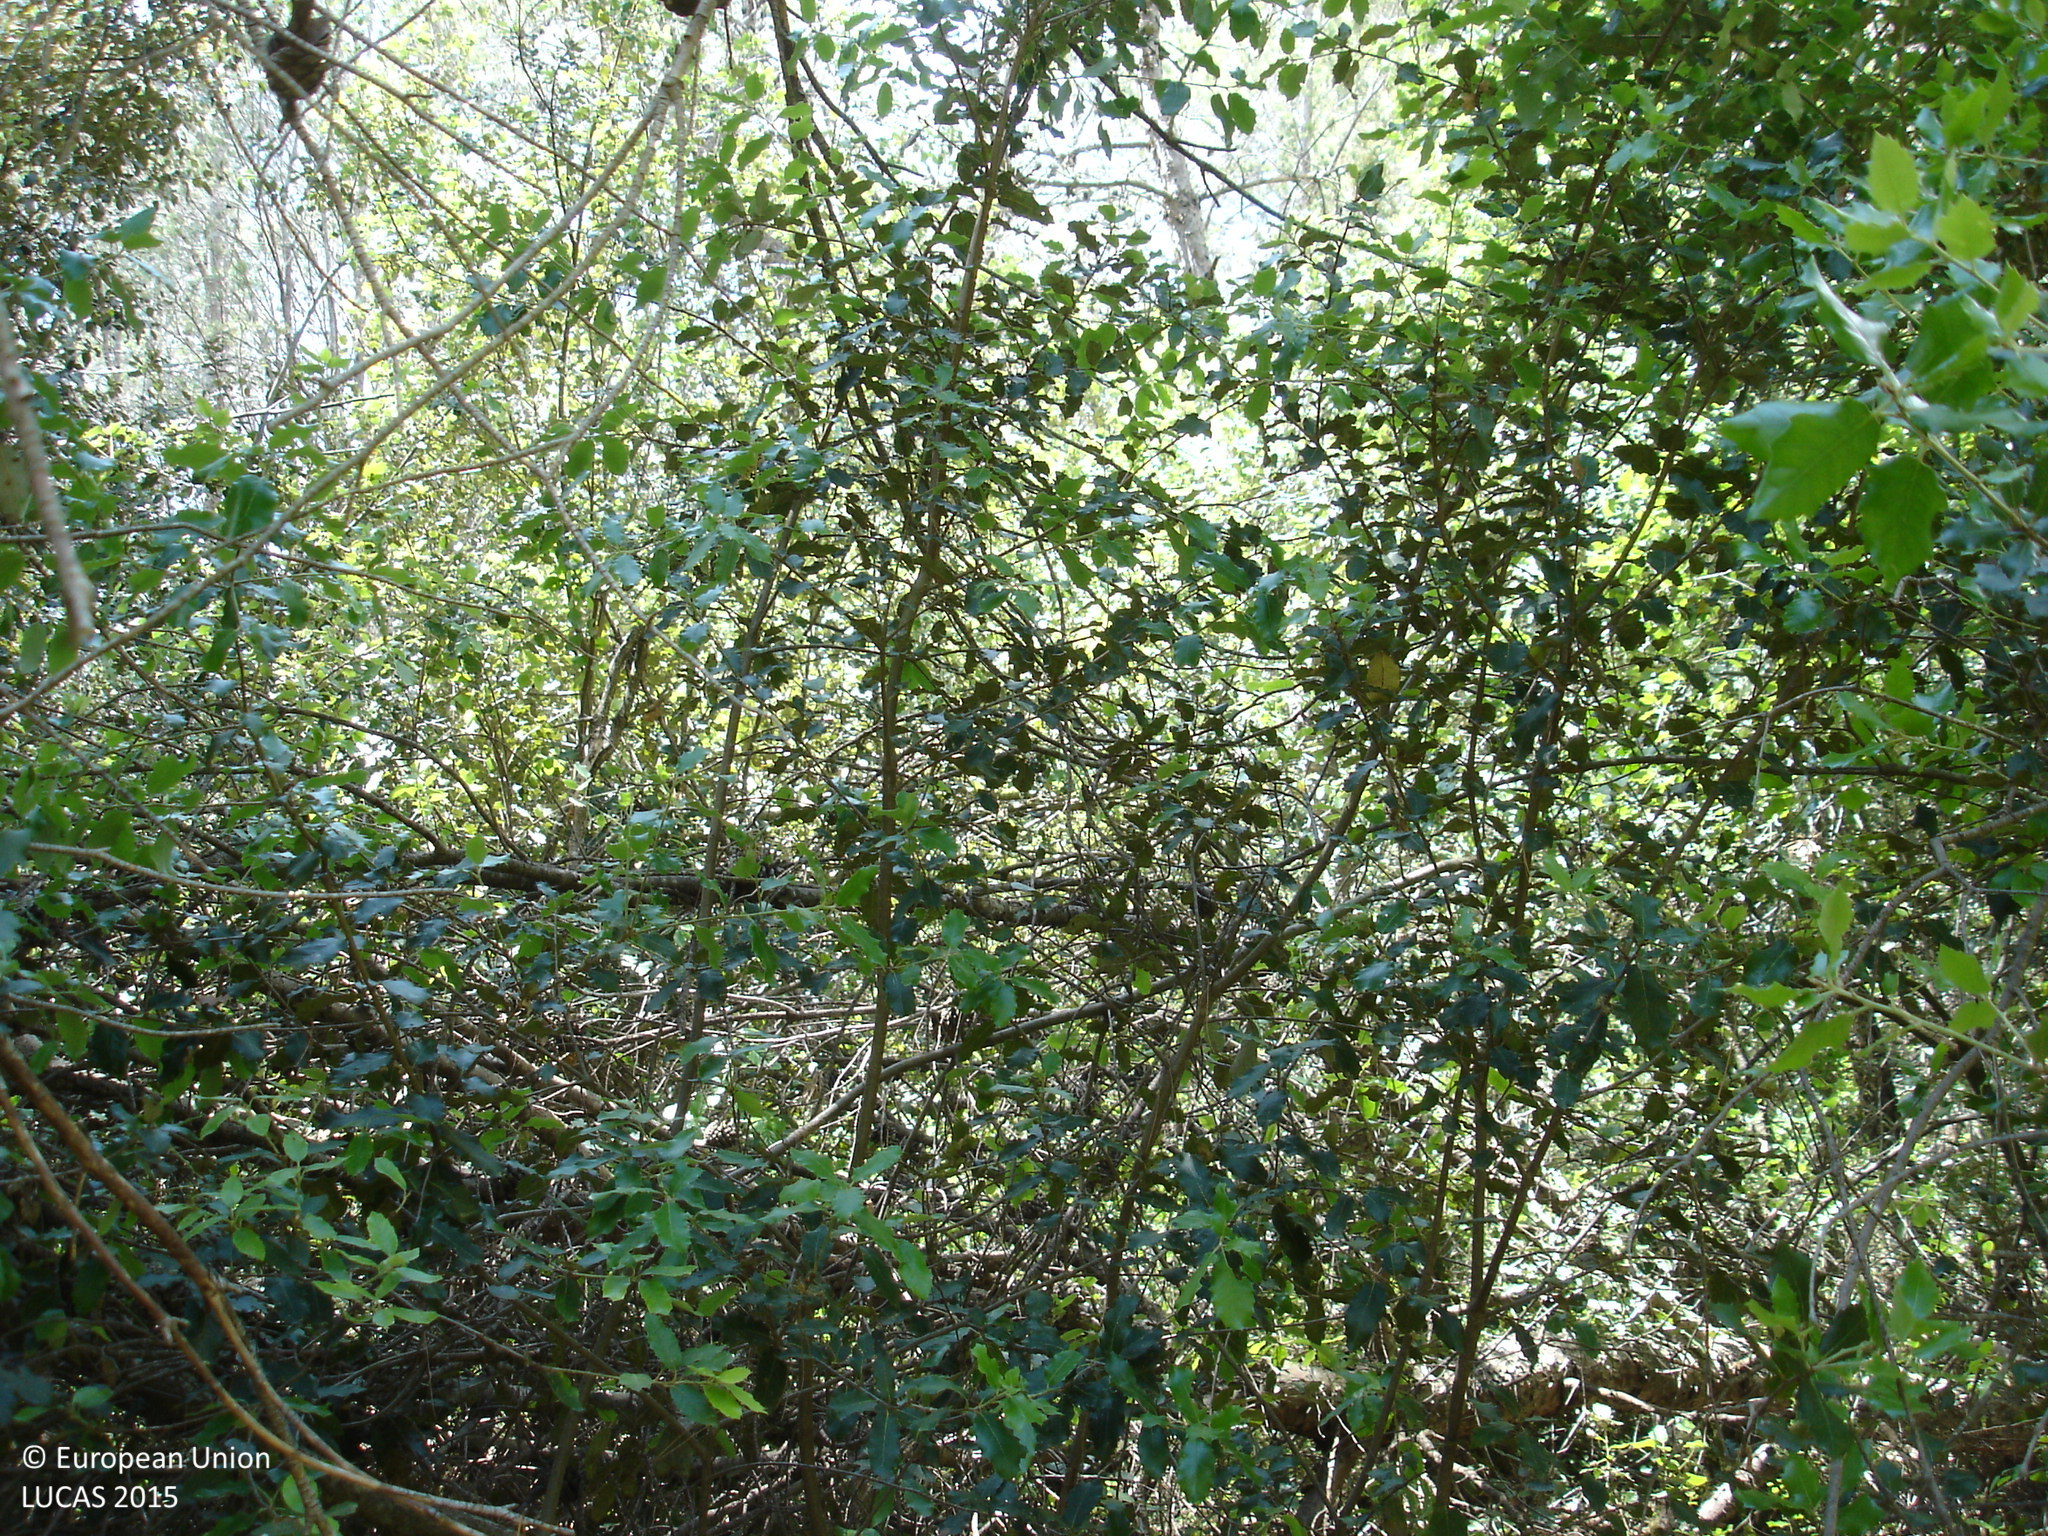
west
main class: Woodland
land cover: Pine dominated coniferous woodland
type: coniferous forest of the mediterranean region
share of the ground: > 75 %
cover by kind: coniferous forest trees 90 %, broadleaved forest trees 5 %, shrubs 5 %
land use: Forestry
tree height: > 5 m
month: May
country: ES
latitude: 42.1405
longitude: 3.0094
